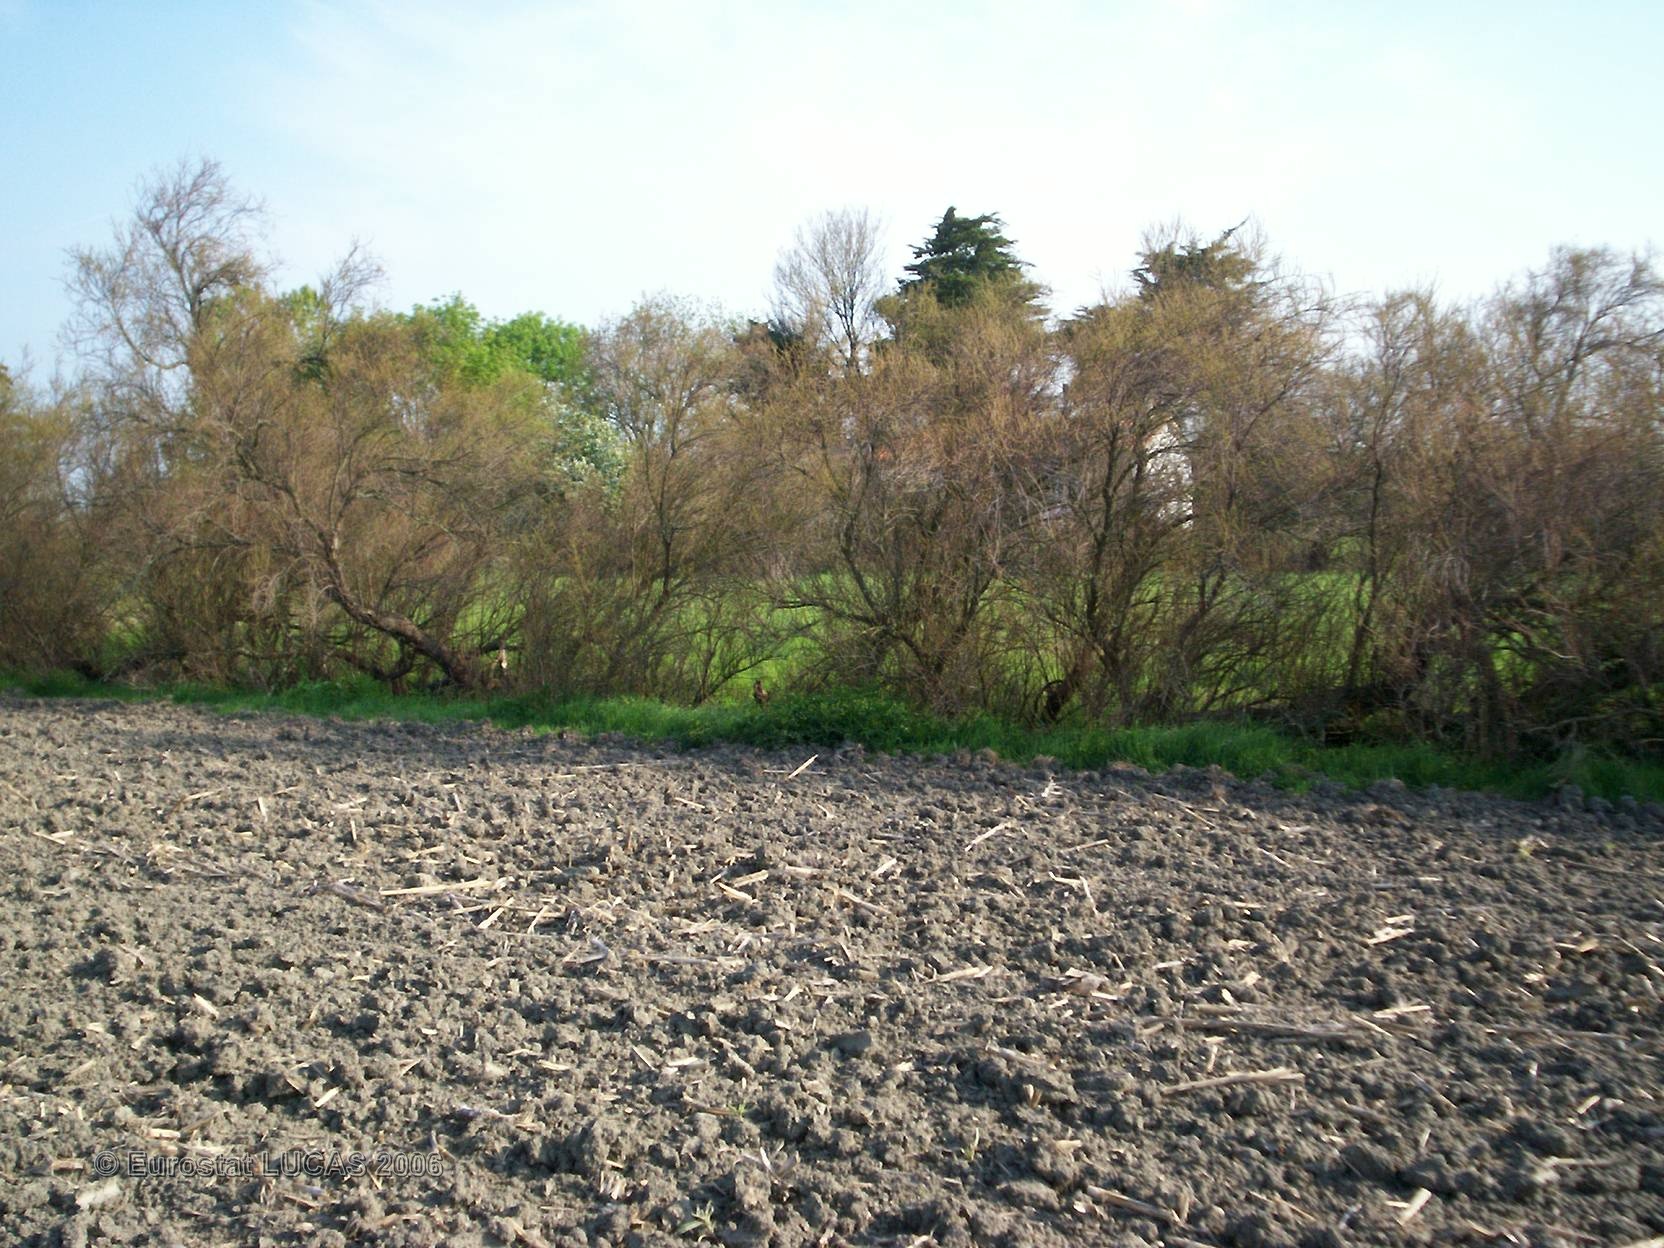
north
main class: Cropland
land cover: Other cereals
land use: Agriculture (excluding fallow land and kitchen gardens)
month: May
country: FR
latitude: 46.8122
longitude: -2.0645
